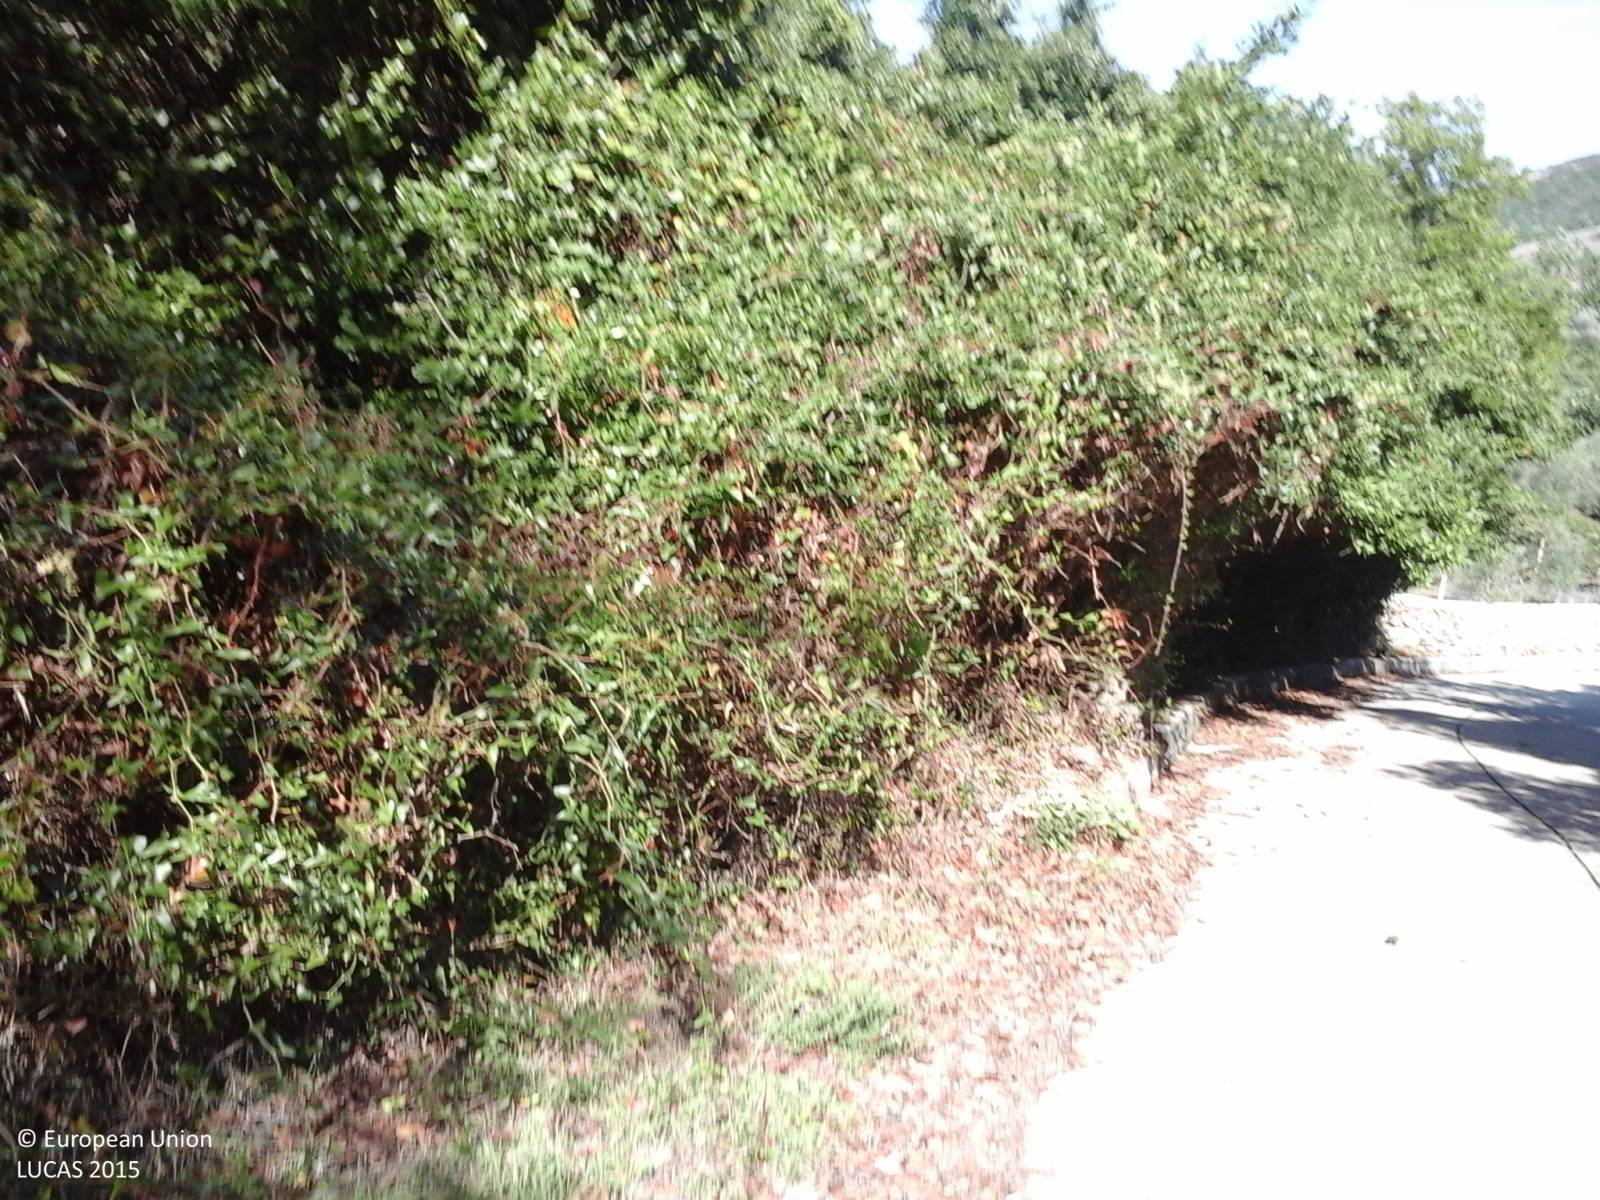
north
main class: Woodland
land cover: Broadleaved woodland
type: broadleaved evergreen forest
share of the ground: > 75 %
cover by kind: broadleaved forest trees 90 %, shrubs 10 %
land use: Semi-natural and natural areas not in use
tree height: > 5 m
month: October
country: IT
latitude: 40.2028
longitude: 8.5859
